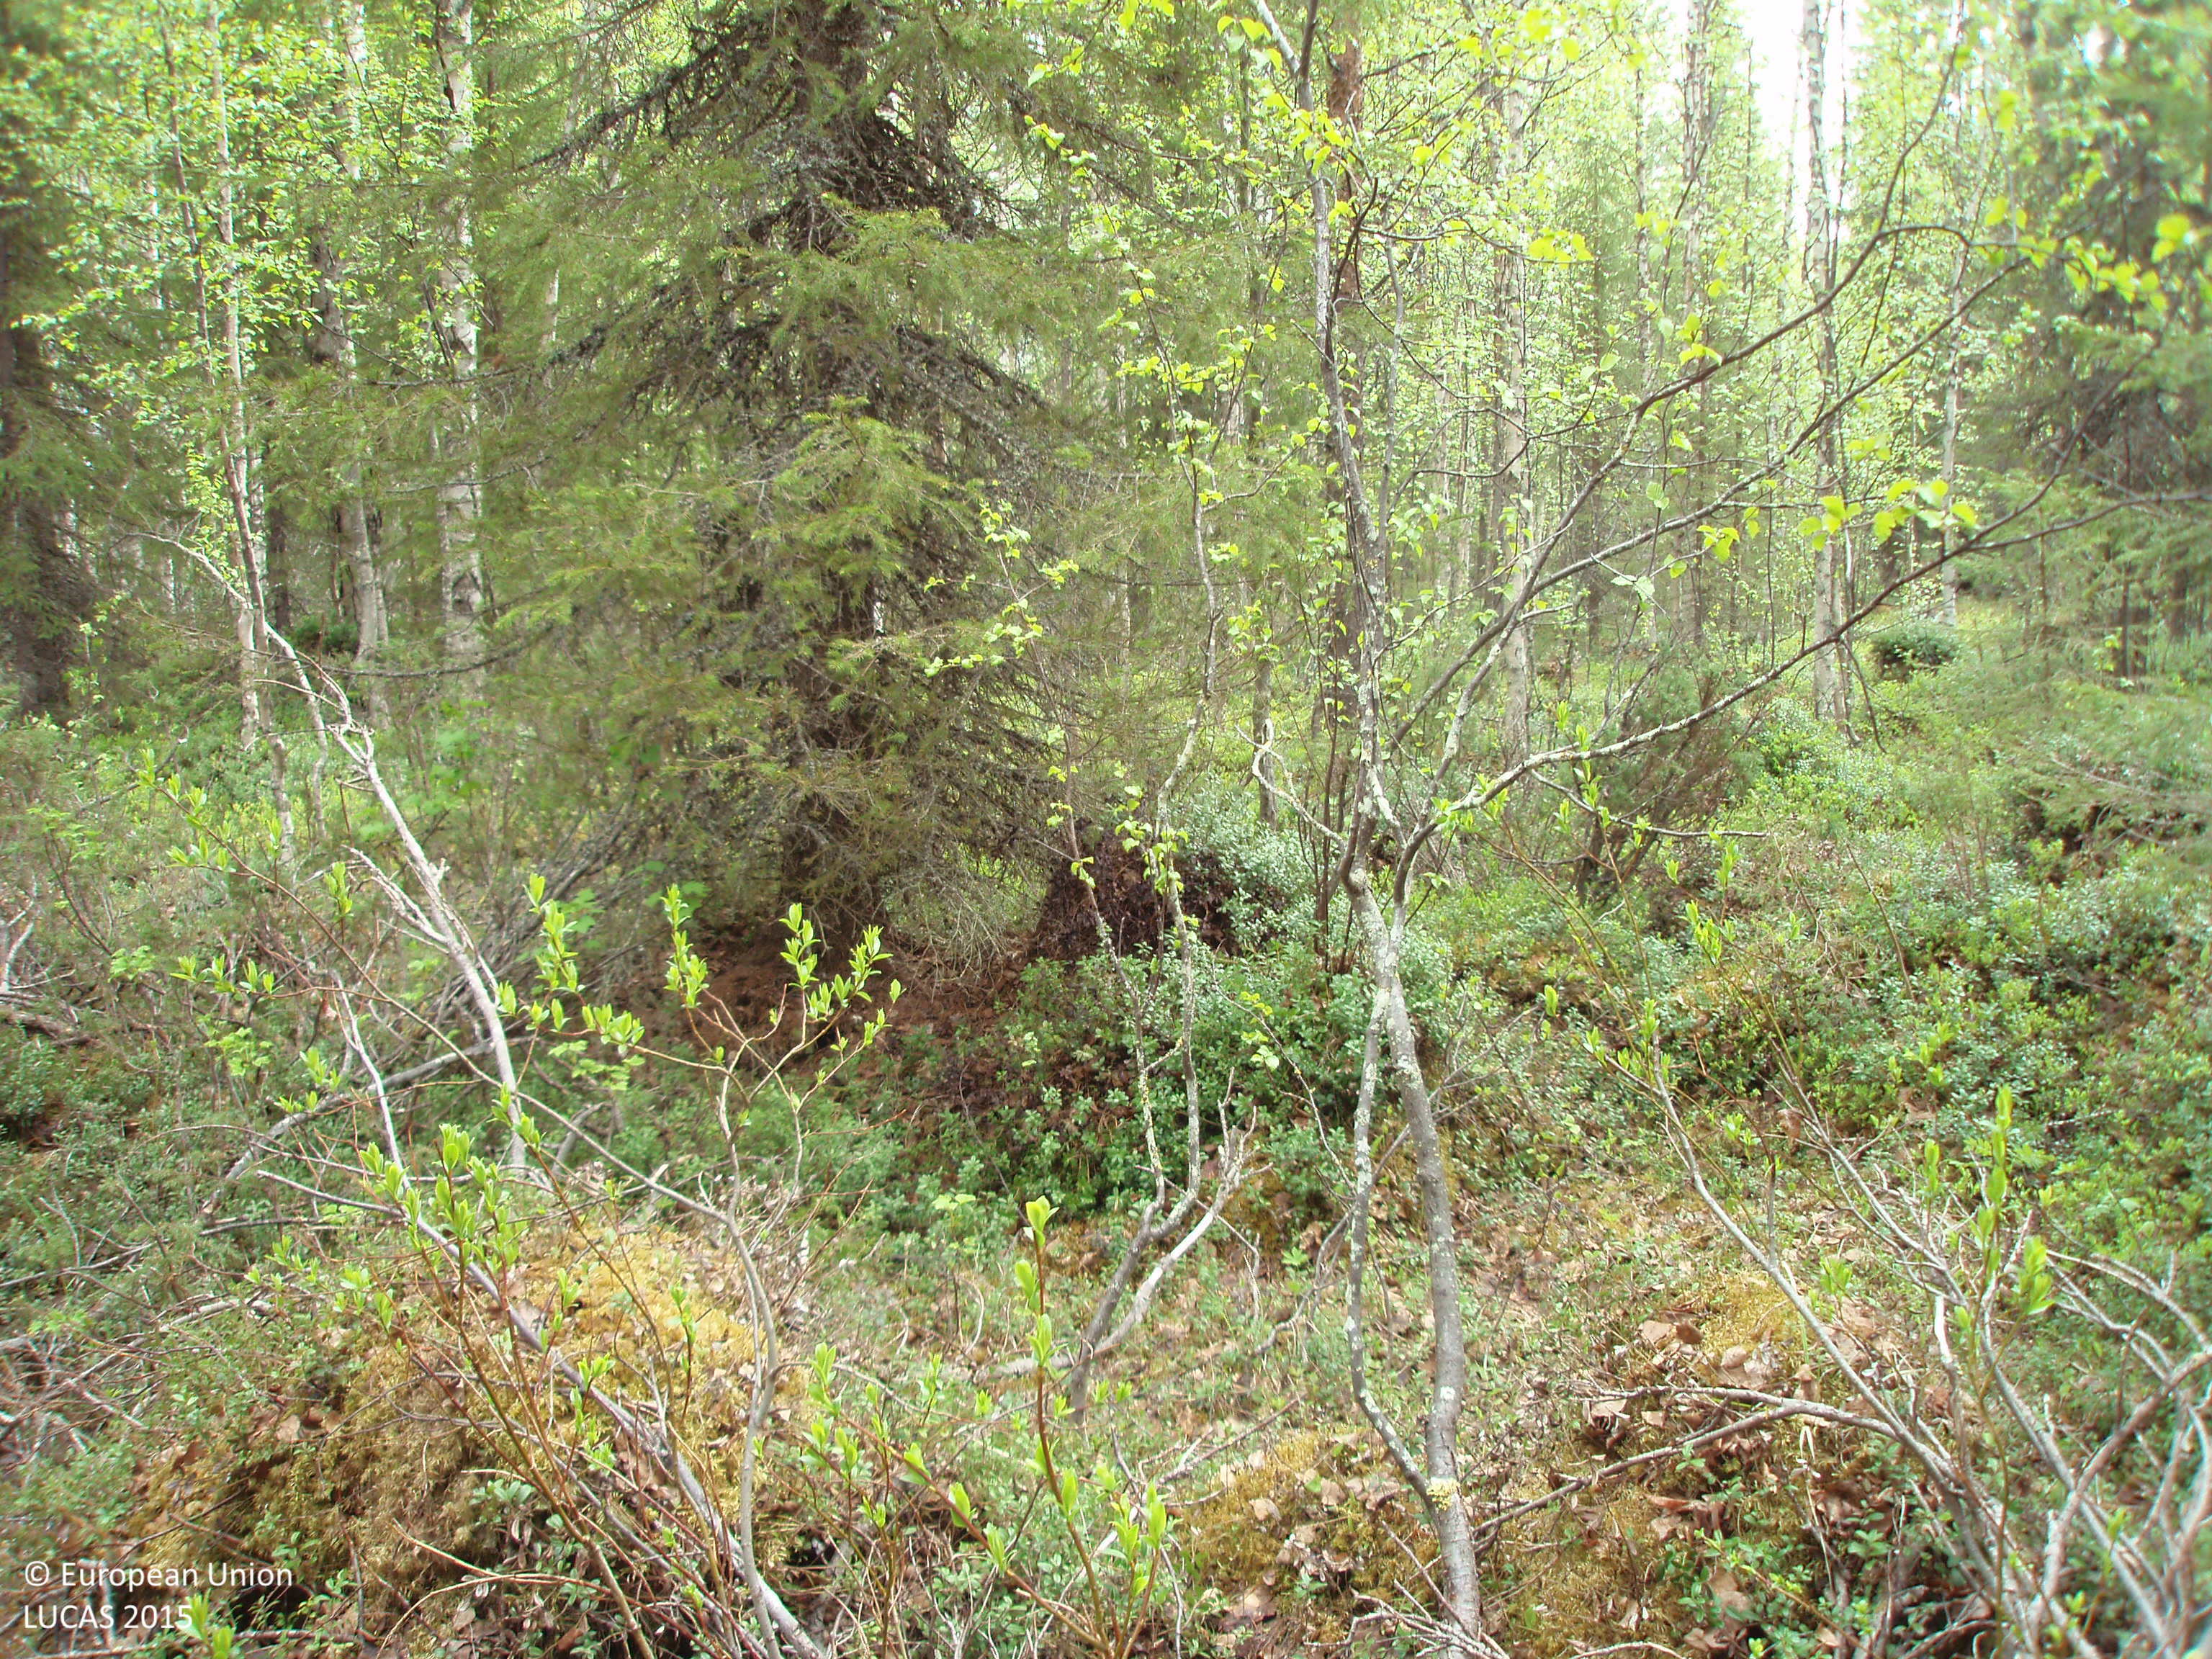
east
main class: Woodland
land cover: Other mixed woodland
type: boreal forest
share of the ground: > 75 %
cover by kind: coniferous forest trees 40 %, broadleaved forest trees 40 %, shrubs 10 %, herbaceous plants 10 %
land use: Forestry
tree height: > 5 m
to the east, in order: Other mixed woodland; Grass margins; Ditches and canals; Shrubland with sparse tree cover; Paved roads, cycling and walking lanes; Shrubland with sparse tree cover; Other mixed woodland; Tracks; Other mixed woodland
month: June
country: FI
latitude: 67.1809
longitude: 26.9320
